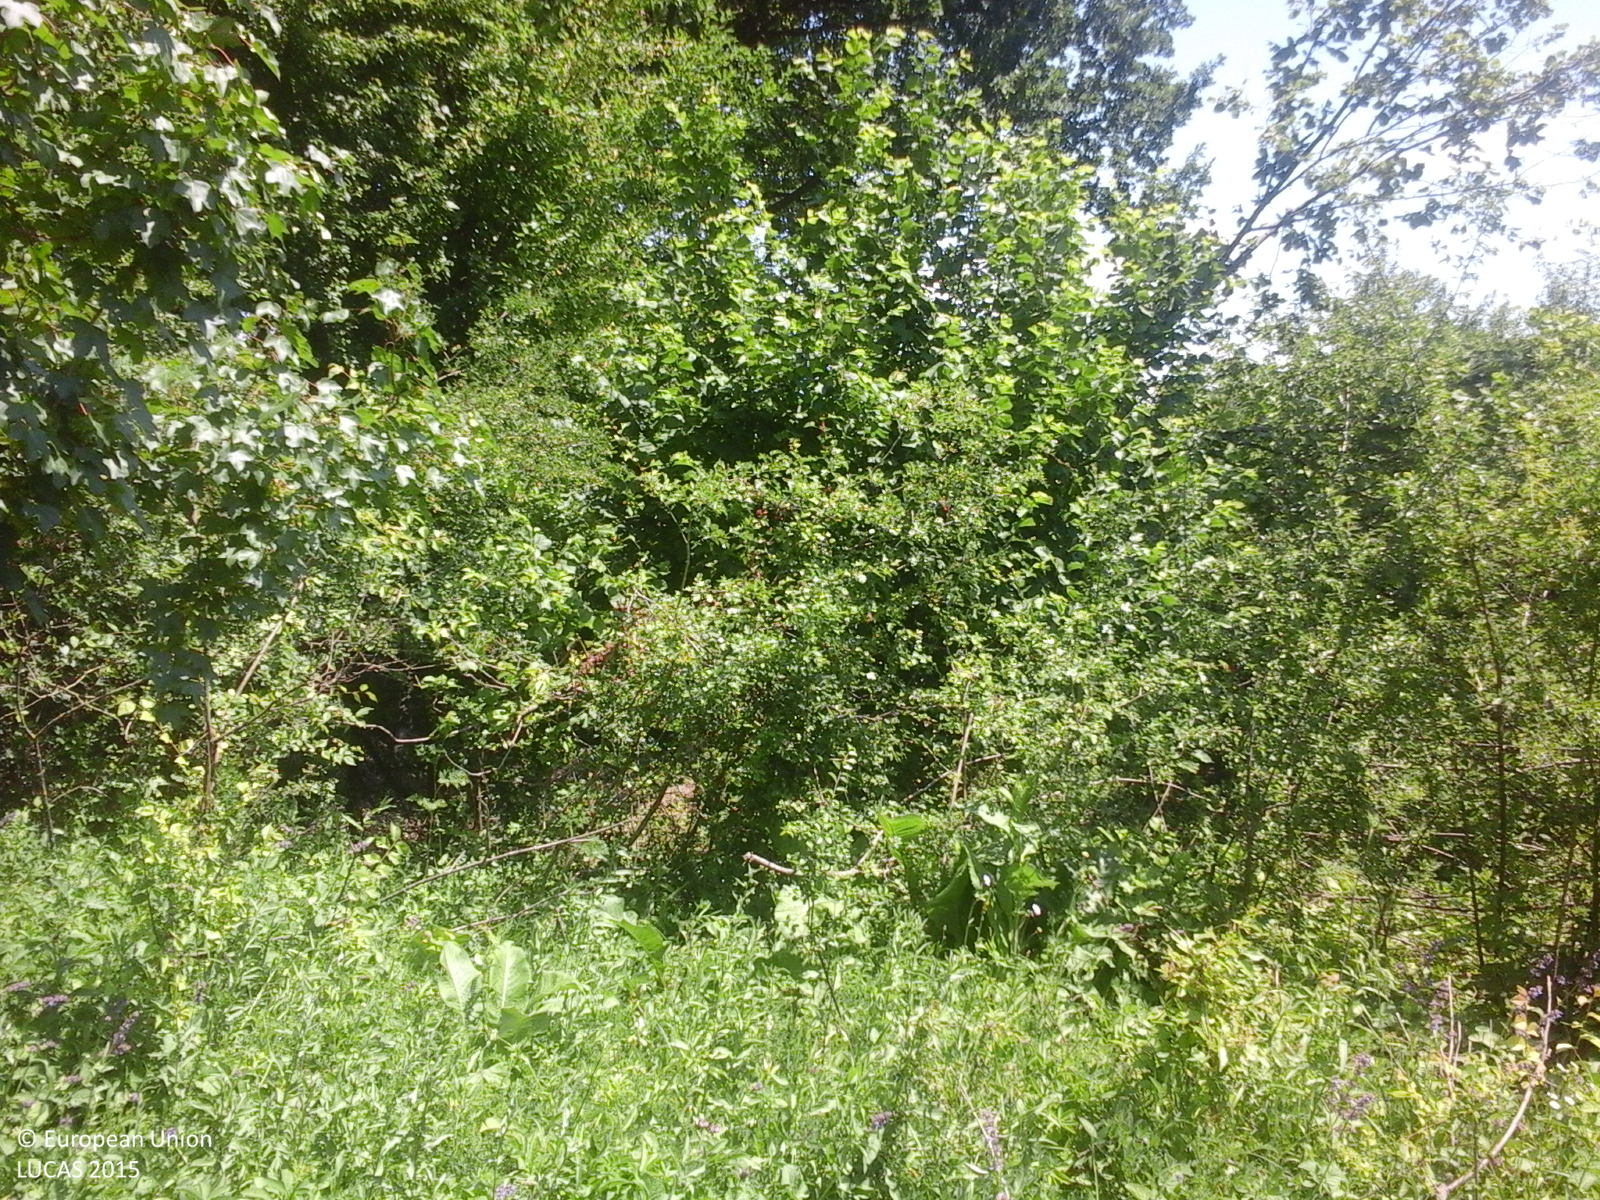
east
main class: Woodland
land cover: Broadleaved woodland
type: mesophytic deciduous forest
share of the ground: > 75 %
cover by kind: broadleaved forest trees 100 %
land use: Forestry
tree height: > 5 m
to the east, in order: Broadleaved woodland; Lucerne; Other leguminous and mixtures for fodder; Maize; Grassland without tree/shrub cover; Broadleaved woodland; Tracks; Broadleaved woodland
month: June
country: RO
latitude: 46.9941
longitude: 27.2678
